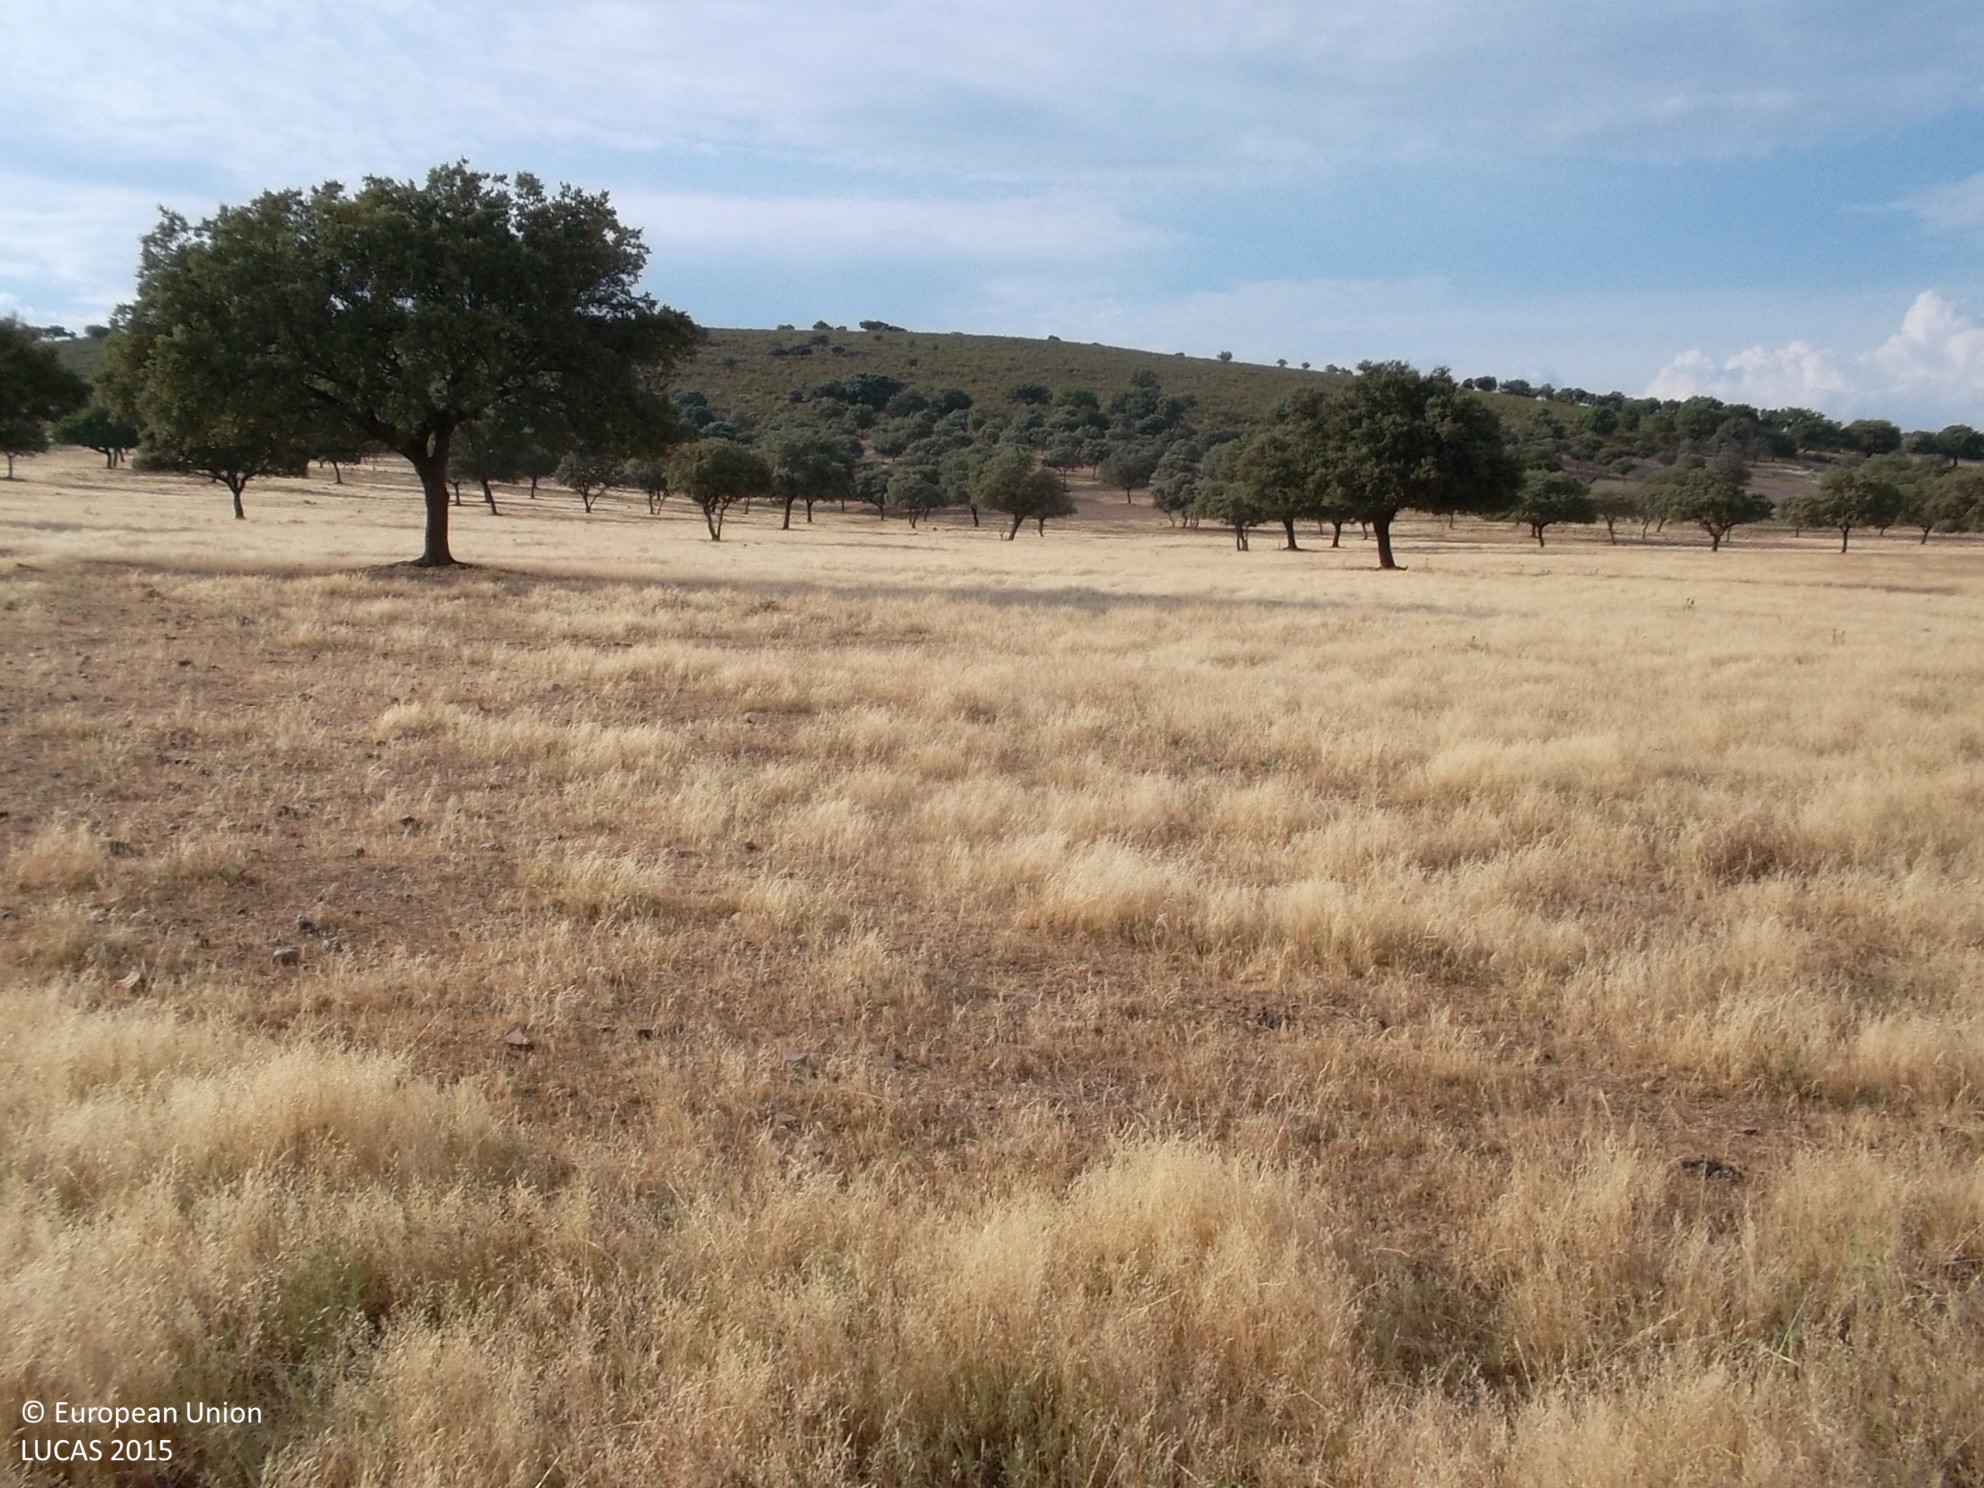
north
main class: Woodland
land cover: Broadleaved woodland
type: broadleaved evergreen forest
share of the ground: 25 - 50 %
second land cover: Spontaneously vegetated surfaces
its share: > 75 %
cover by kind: herbaceous plants 60 %, broadleaved forest trees 40 %
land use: Forestry
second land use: Agriculture (excluding fallow land and kitchen gardens)
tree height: > 5 m
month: June
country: ES
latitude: 39.2467
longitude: -4.9278
